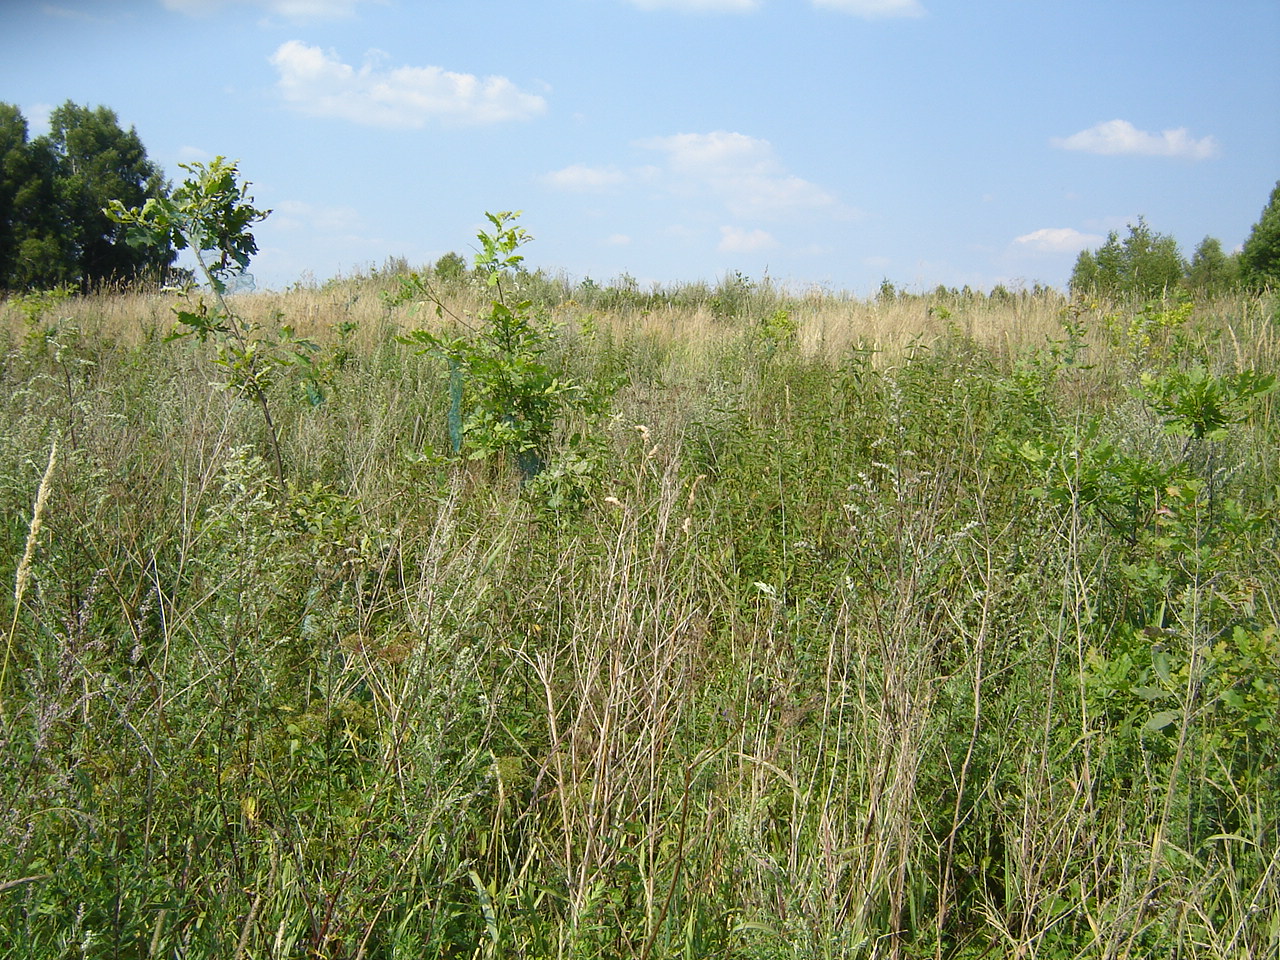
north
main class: Woodland
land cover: Broadleaved woodland
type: non-riverine alder, birch or aspen forest
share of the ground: 10 - 25 %
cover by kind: herbaceous plants 85 %, broadleaved forest trees 15 %
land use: Forestry
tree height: < 5 m
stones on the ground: < 10 %
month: August
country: LT
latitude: 55.1550
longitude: 25.4249
